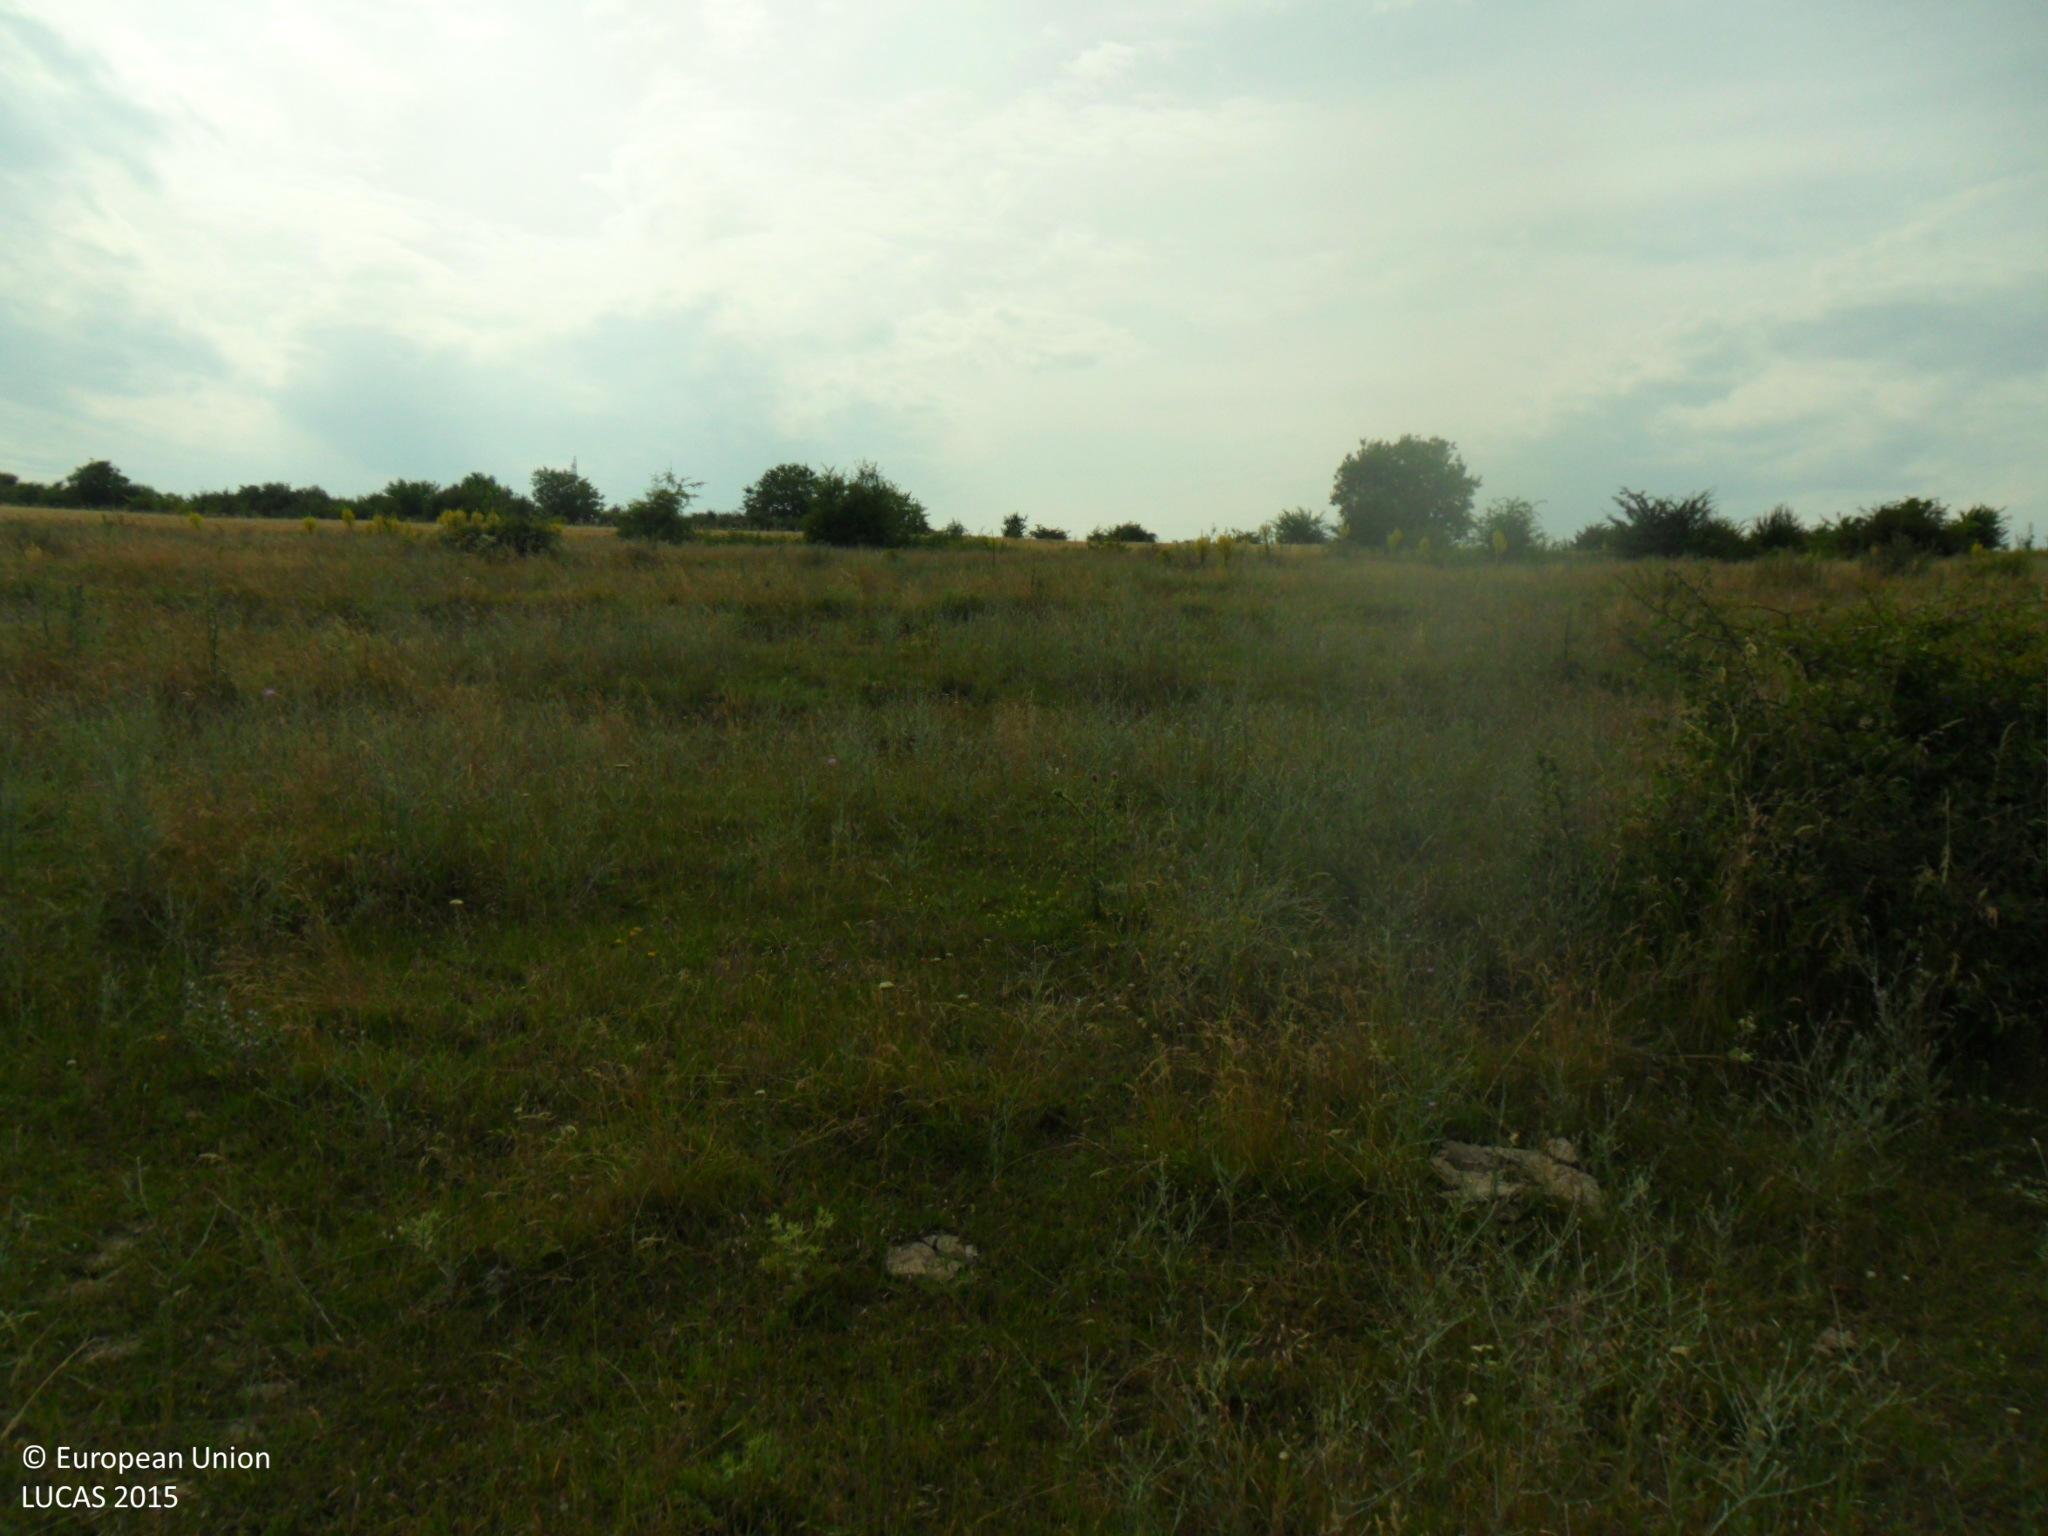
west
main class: Grassland
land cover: Grassland without tree/shrub cover
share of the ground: > 75 %
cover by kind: herbaceous plants 100 %
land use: Agriculture (excluding fallow land and kitchen gardens)
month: June
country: BG
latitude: 43.5875
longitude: 26.6183
